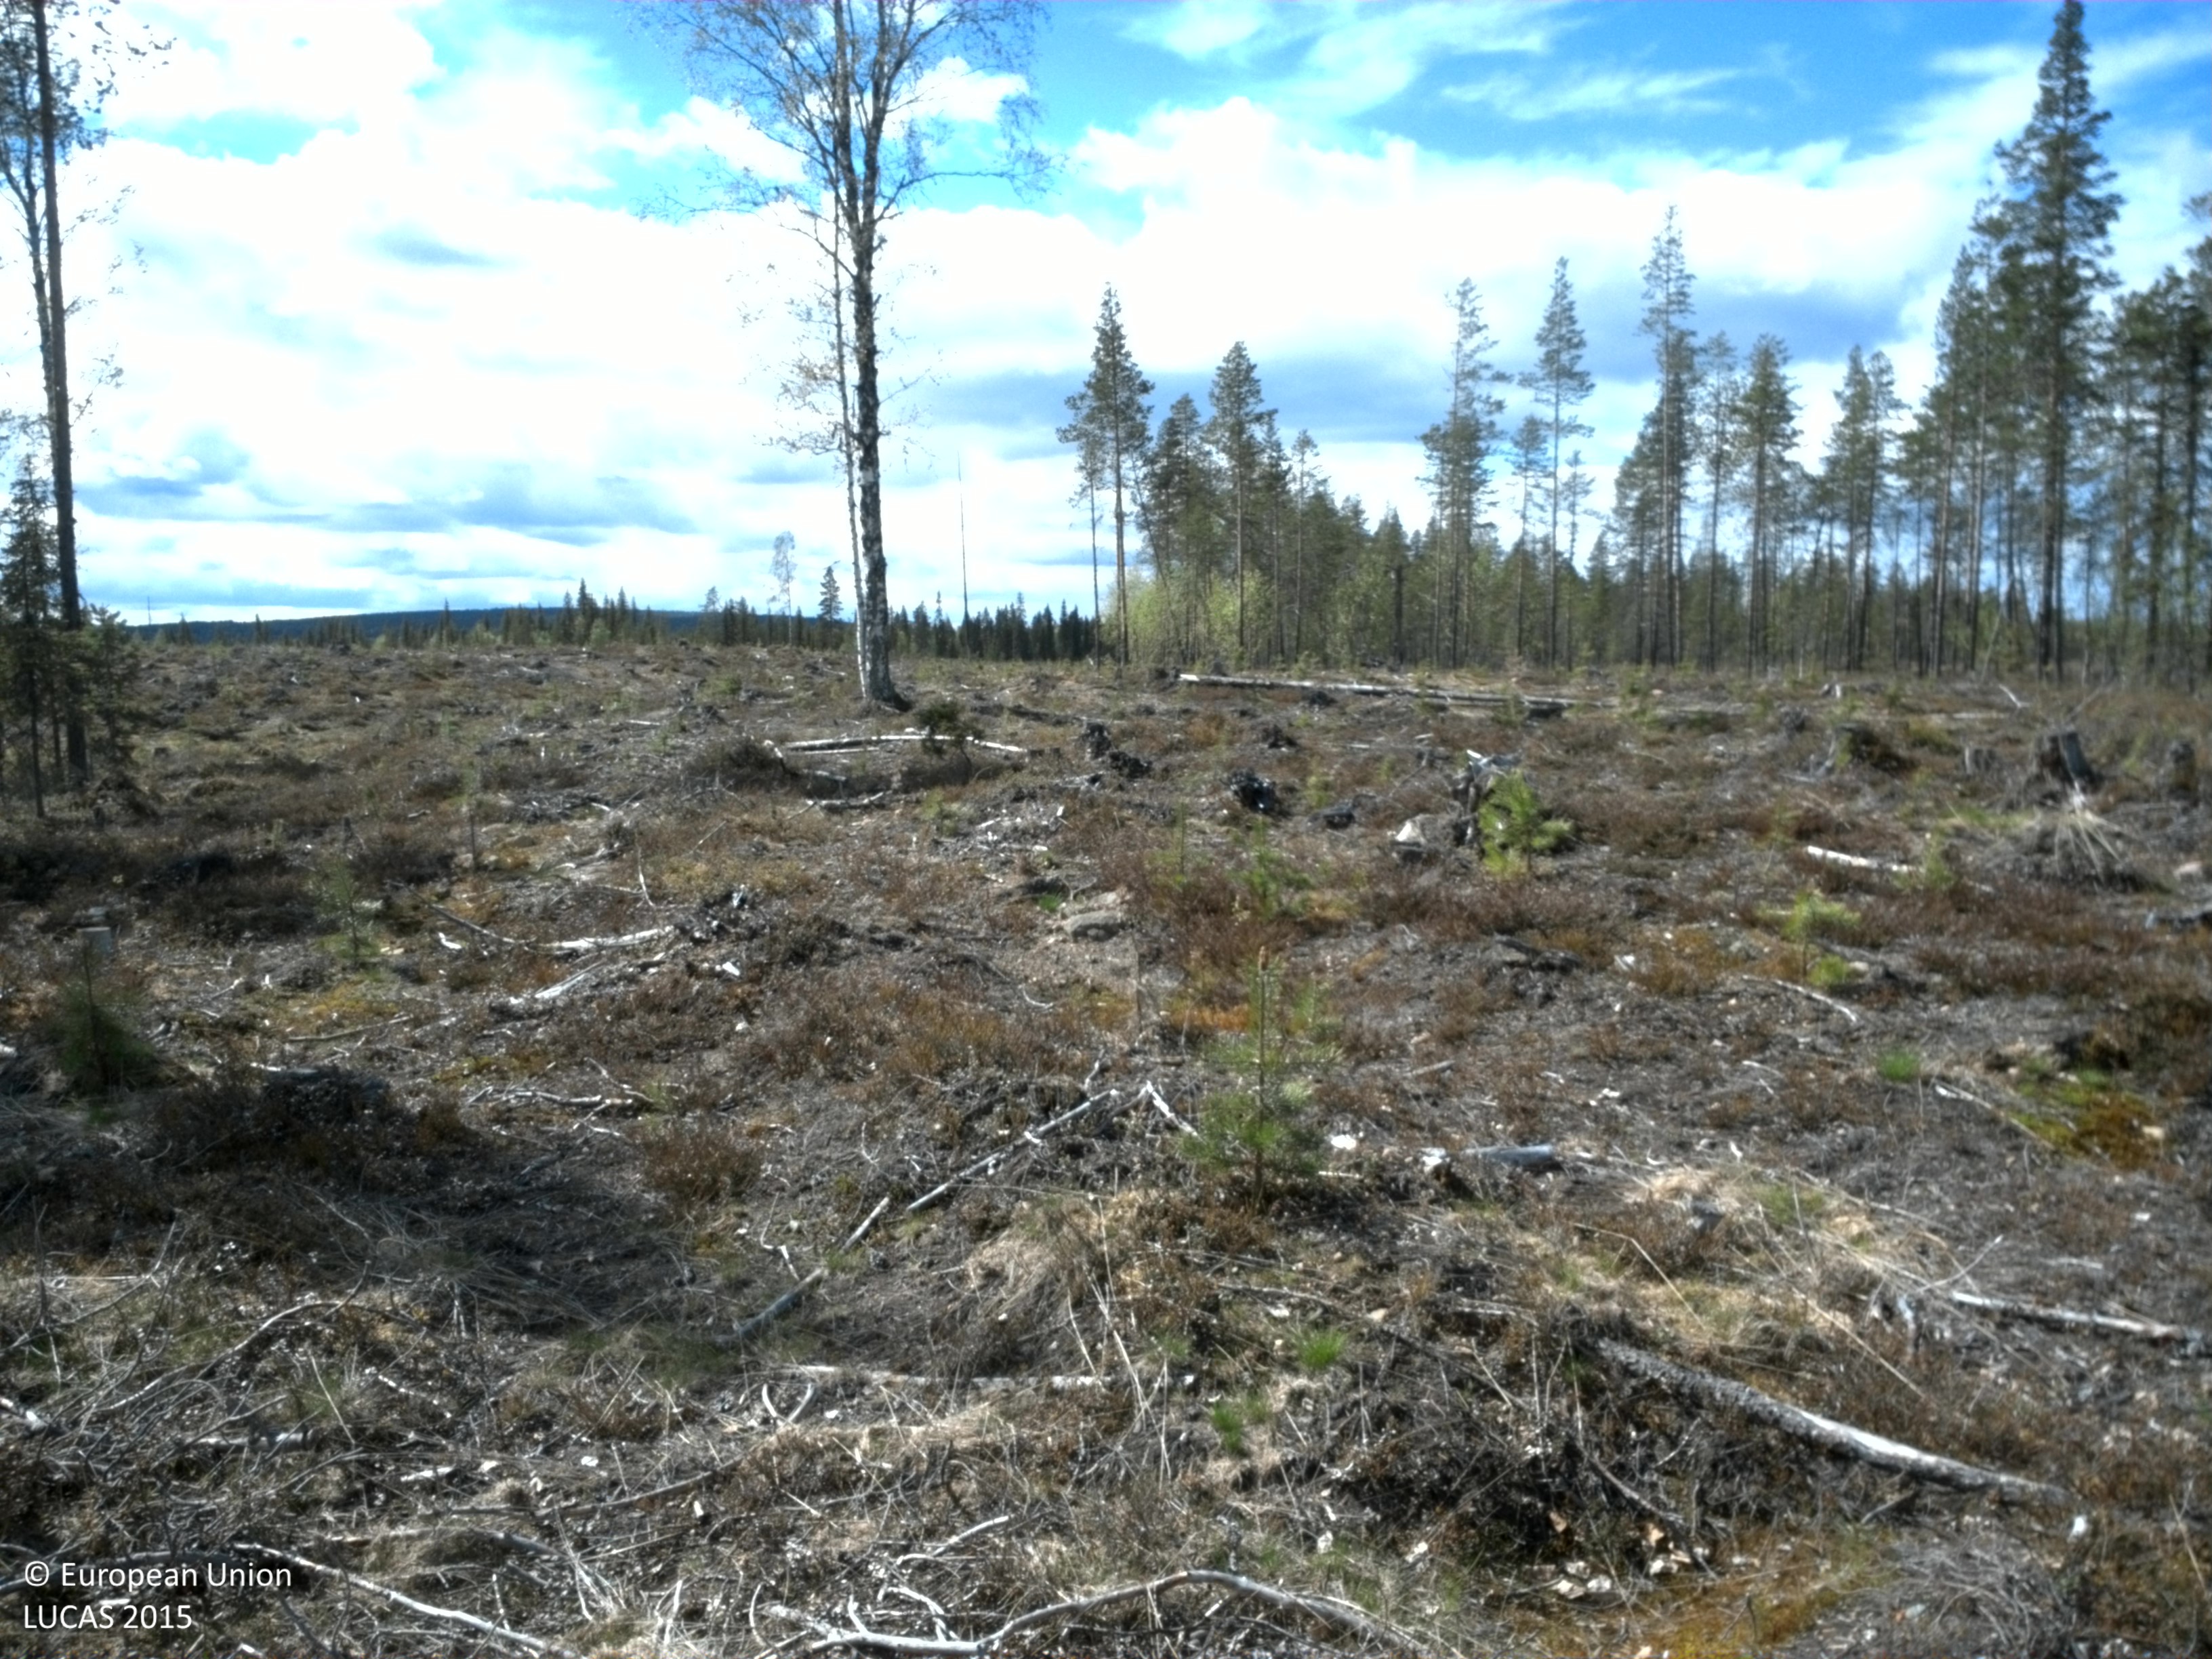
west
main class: Shrubland
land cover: Shrubland with sparse tree cover
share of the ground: 10 - 25 %
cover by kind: herbaceous plants 55 %, unconsolidated bare surface 25 %, shrubs 15 %, coniferous forest trees 5 %
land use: Forestry
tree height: < 5 m
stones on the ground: < 10 %
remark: Clear cut
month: June
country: SE
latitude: 66.9747
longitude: 21.3421
